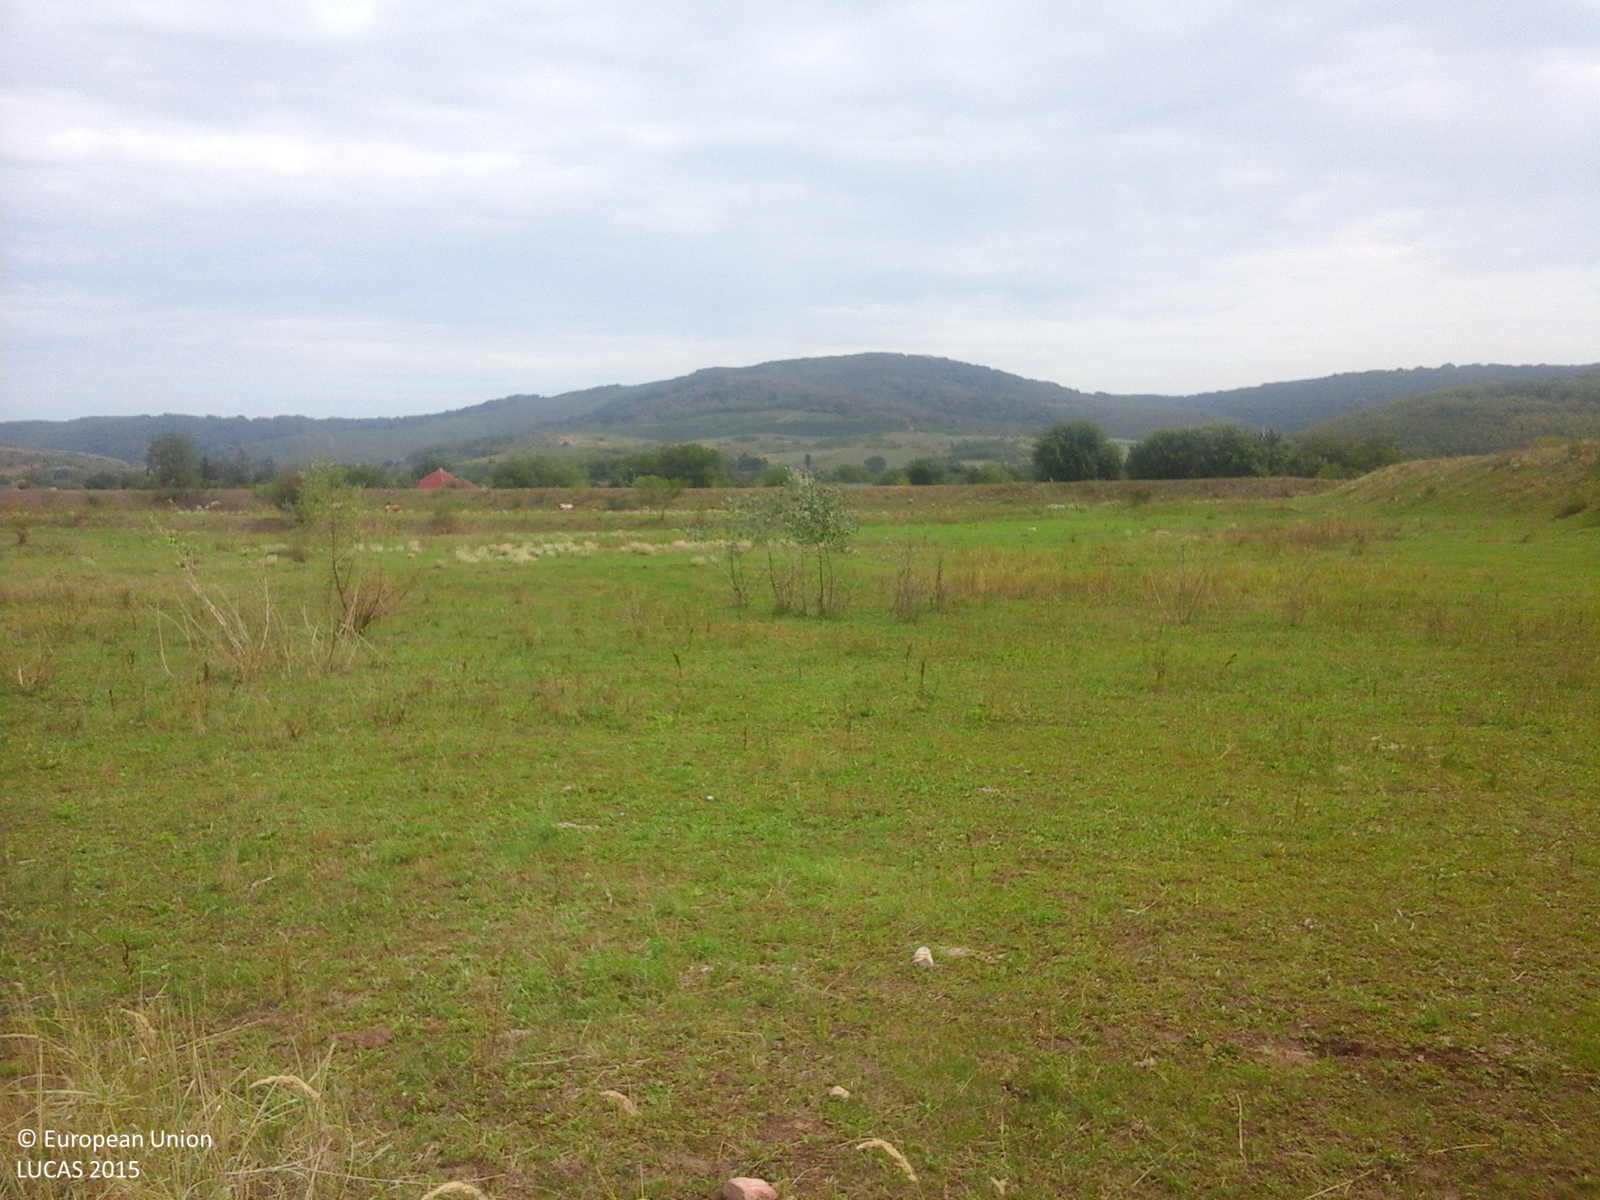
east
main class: Grassland
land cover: Spontaneously vegetated surfaces
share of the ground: > 75 %
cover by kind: herbaceous plants 100 %
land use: Fallow land
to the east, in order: Spontaneously vegetated surfaces; Grassland without tree/shrub cover; Spontaneously vegetated surfaces; Grassland without tree/shrub cover; Abandoned hedges; Tracks; Grass margins; Electric lines; Grassland without tree/shrub cover; Artificial constructions; Grassland with sparse tree/shrub cover
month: August
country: RO
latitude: 46.1365
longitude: 21.5963
